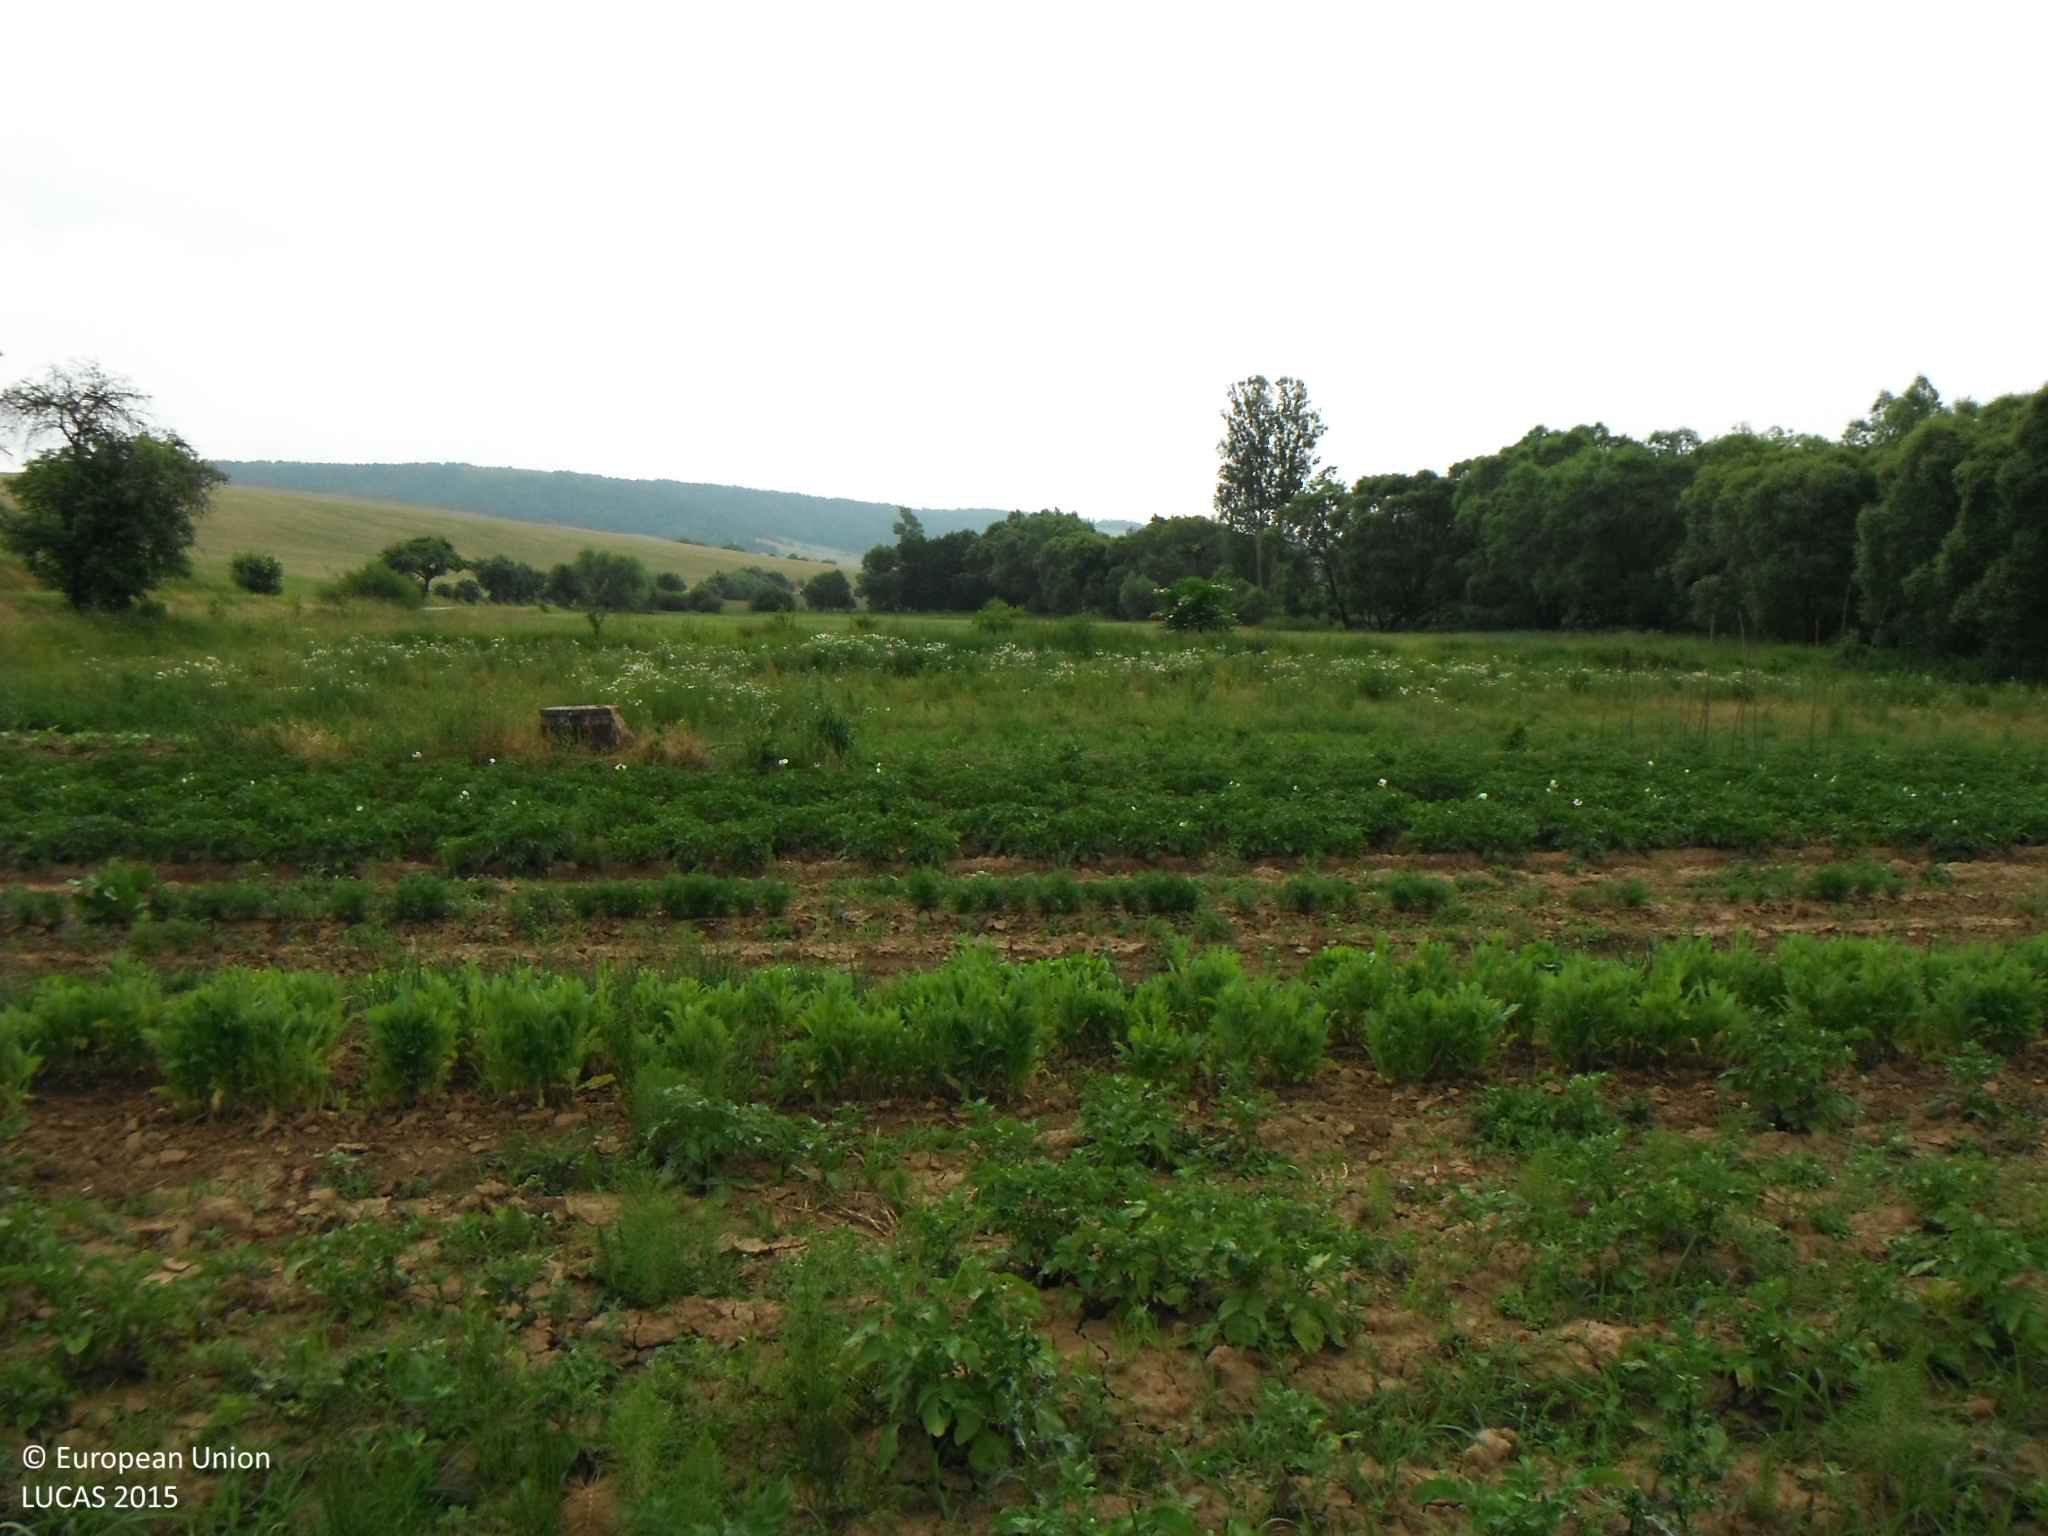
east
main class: Cropland
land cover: Potatoes
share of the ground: 25 - 50 %
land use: Kitchen garden
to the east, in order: Potatoes; Other fresh vegetables; Potatoes; Dry pulses; Spontaneously vegetated surfaces; Common wheat; Potatoes; Other fresh vegetables; Maize; Barley; Common wheat; Barley; Potatoes; Lucerne; Spontaneously vegetated surfaces
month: June
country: SK
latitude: 49.1398
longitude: 21.3831
